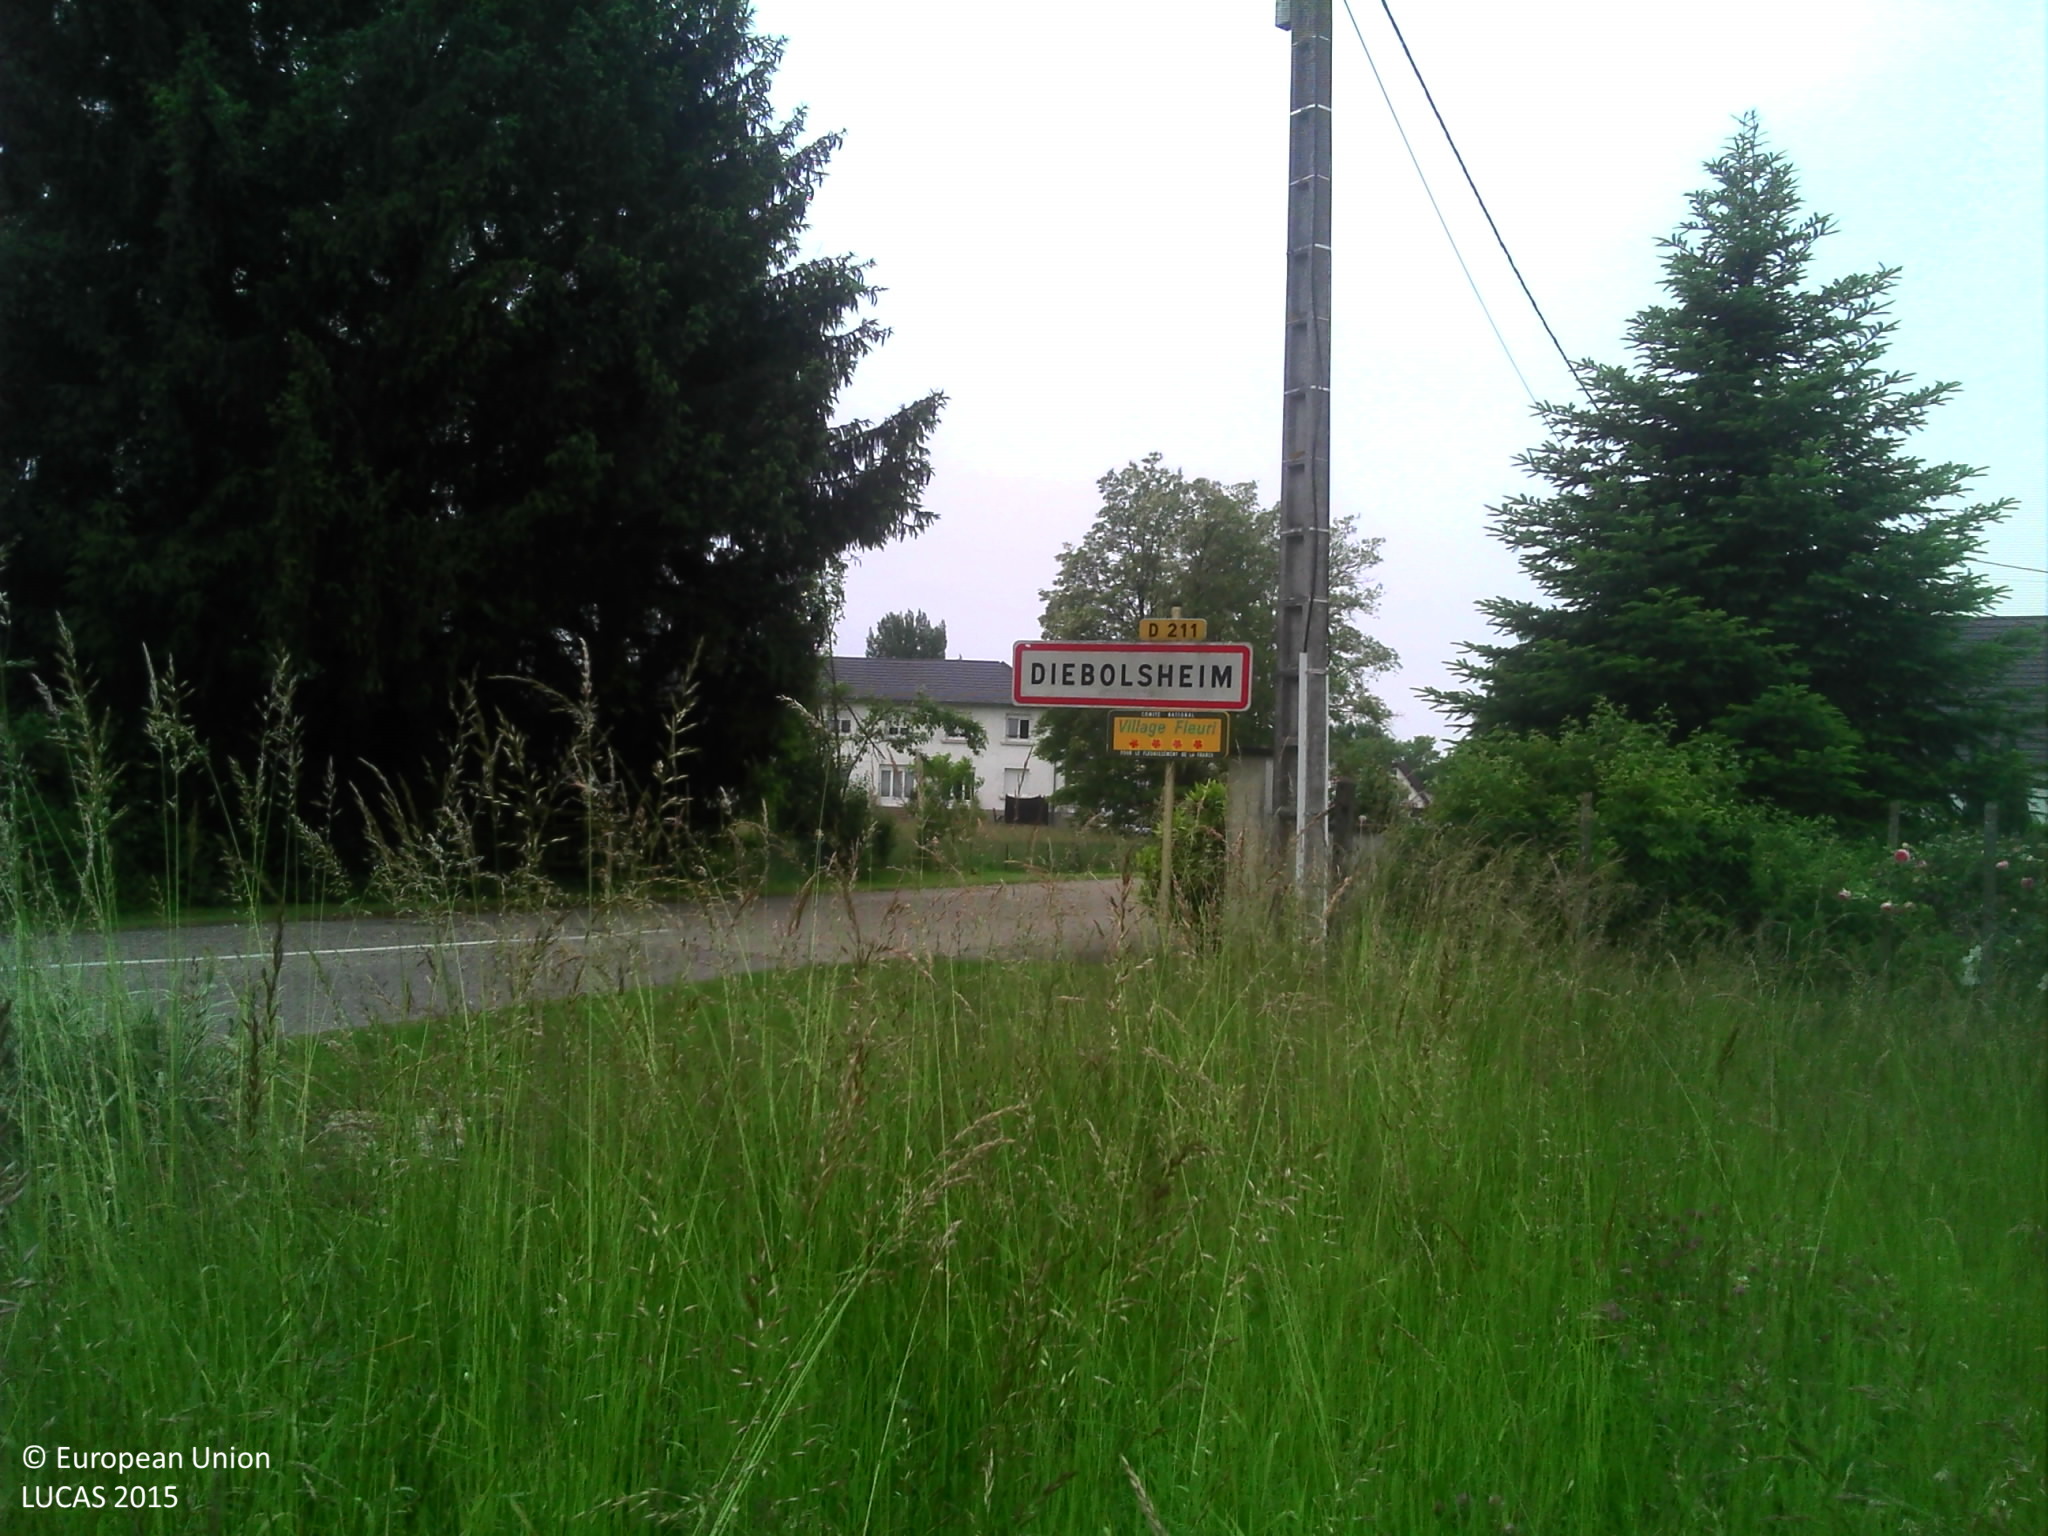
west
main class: Grassland
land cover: Grassland without tree/shrub cover
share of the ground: > 75 %
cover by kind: herbaceous plants 100 %
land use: Agriculture (excluding fallow land and kitchen gardens)
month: May
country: FR
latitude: 48.2889
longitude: 7.6693
